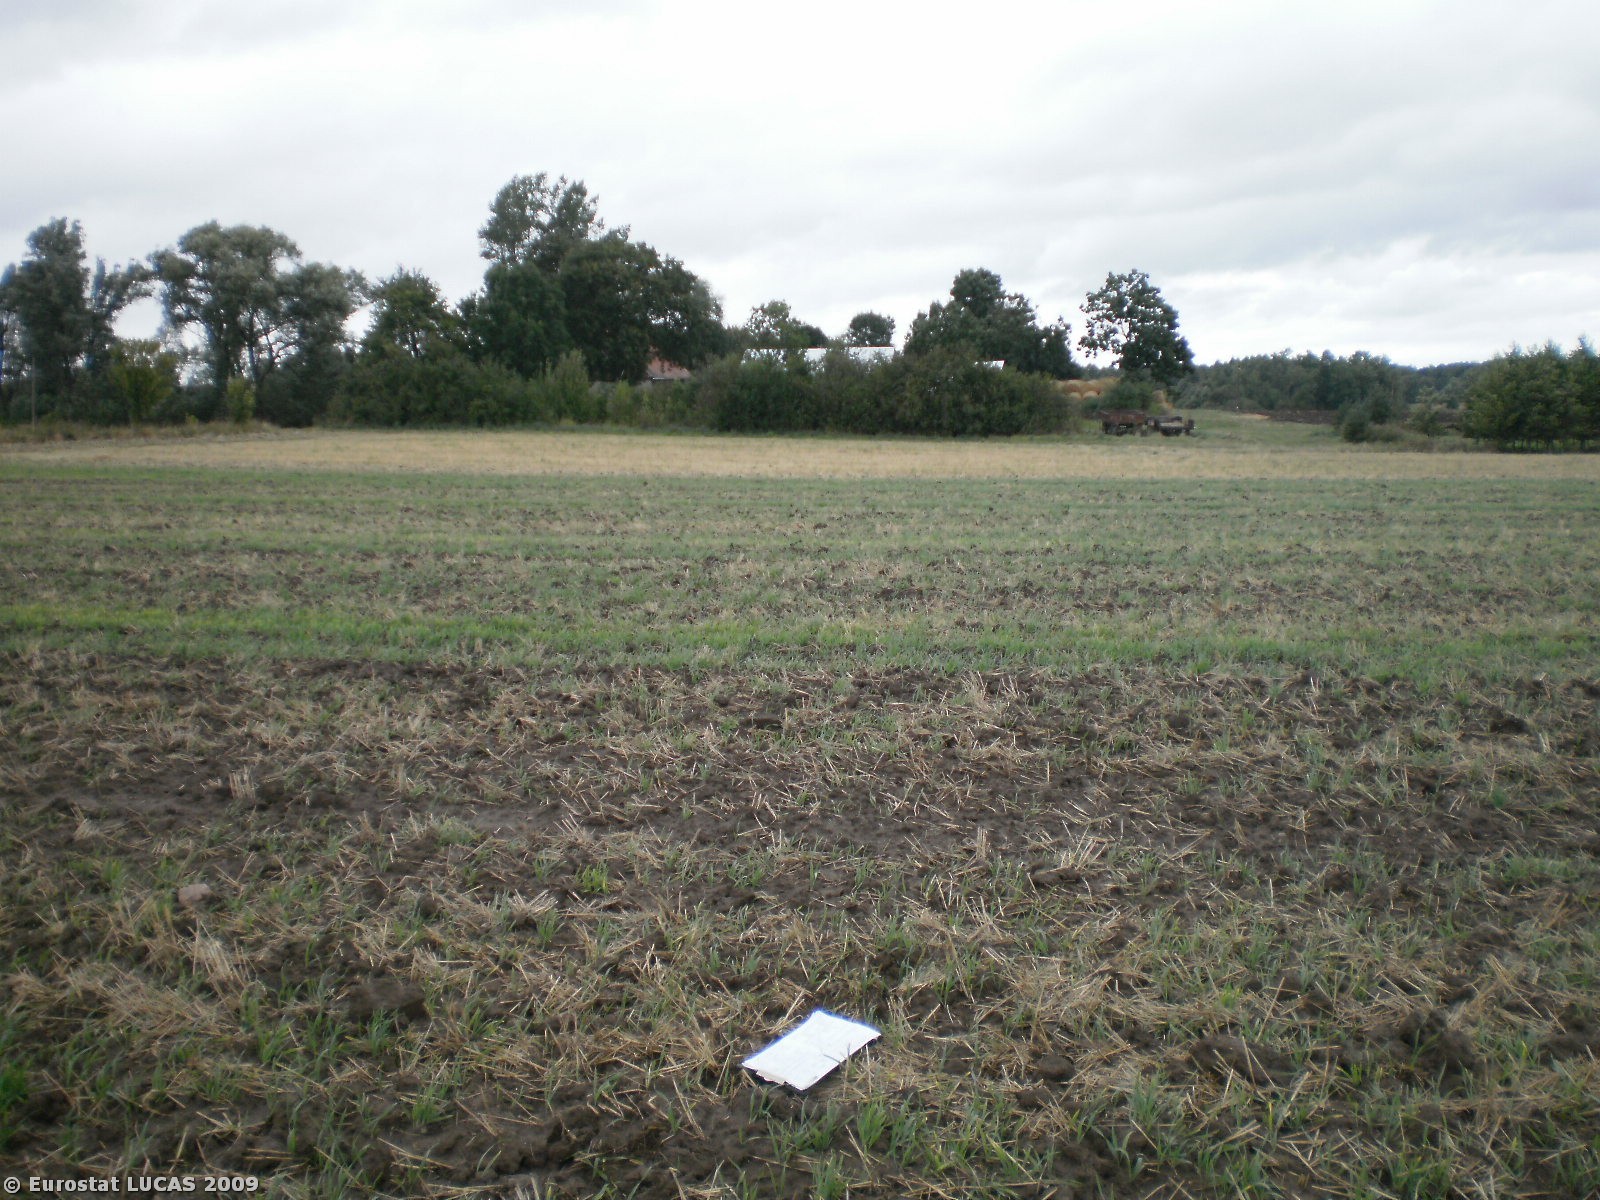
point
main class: Cropland
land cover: Barley
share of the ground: < 10 %
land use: Agriculture (excluding fallow land and kitchen gardens)
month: September
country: PL
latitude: 53.6256
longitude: 17.7090
